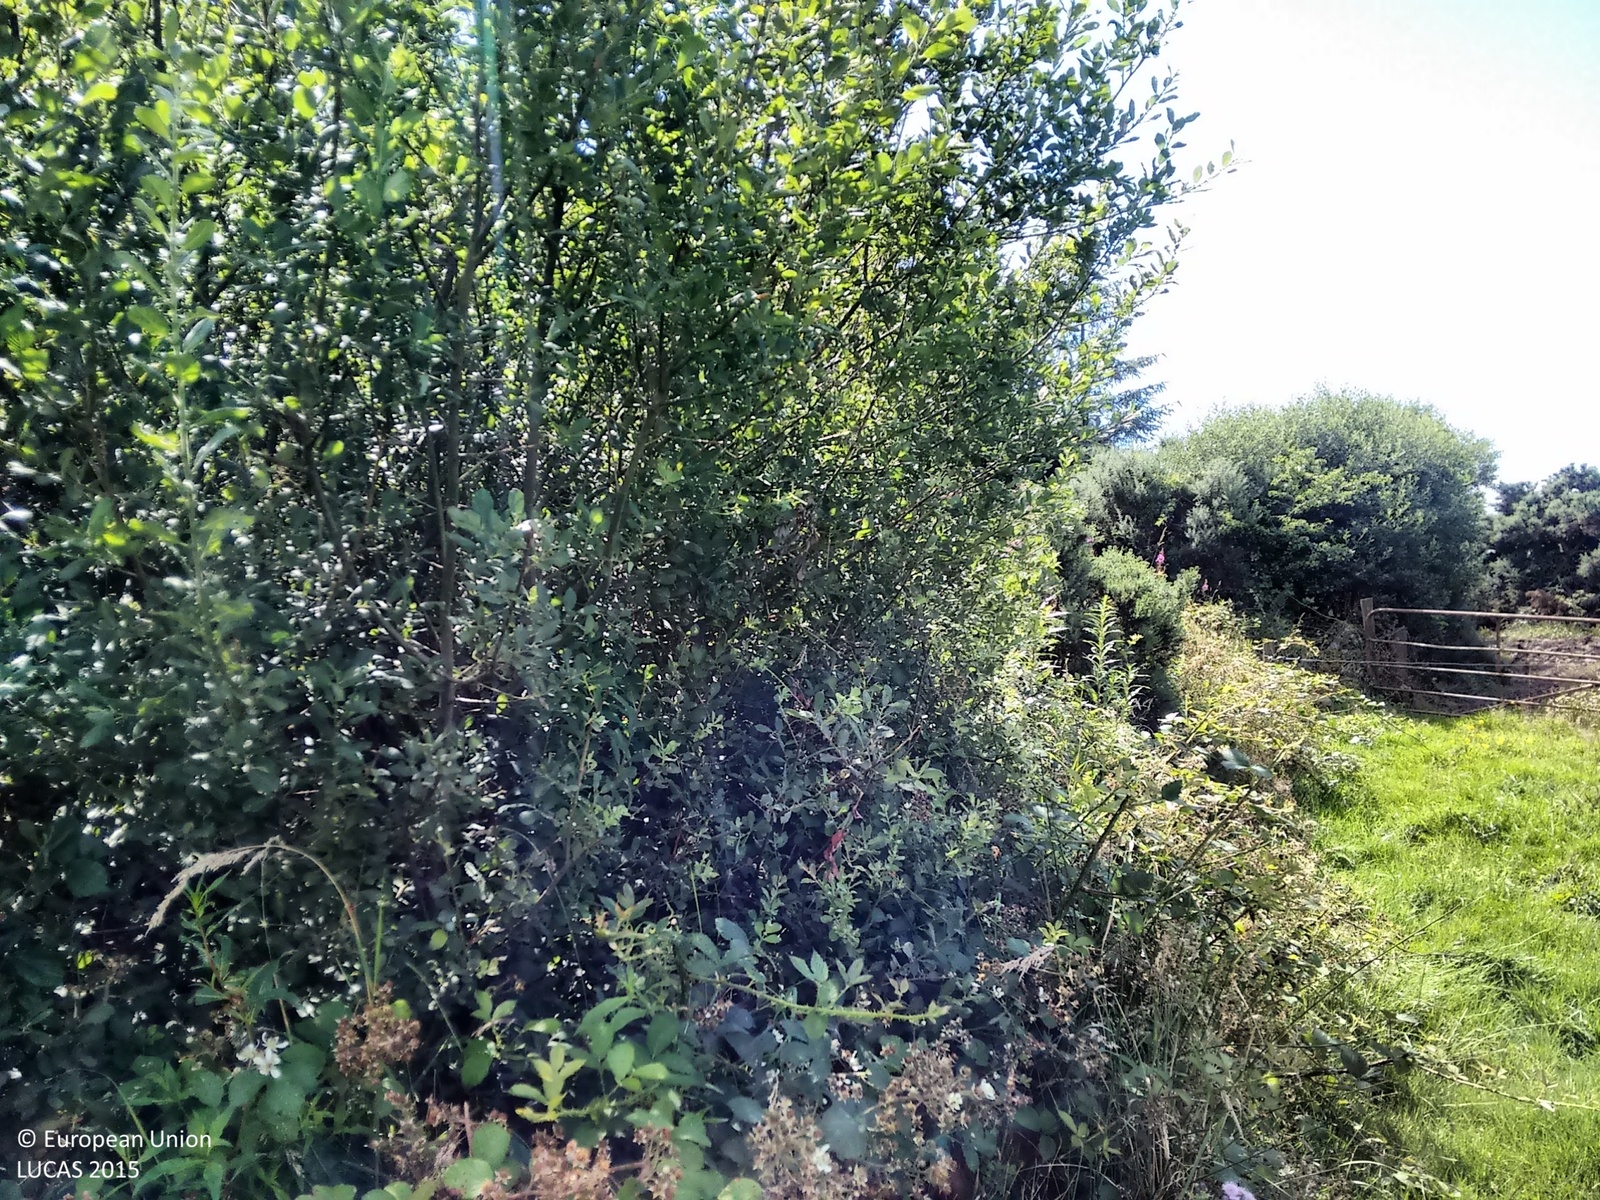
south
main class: Woodland
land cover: Broadleaved woodland
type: mesophytic deciduous forest
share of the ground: > 75 %
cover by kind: broadleaved forest trees 85 %, shrubs 15 %
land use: Forestry
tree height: > 5 m
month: August
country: IE
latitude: 52.4034
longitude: -7.1540
